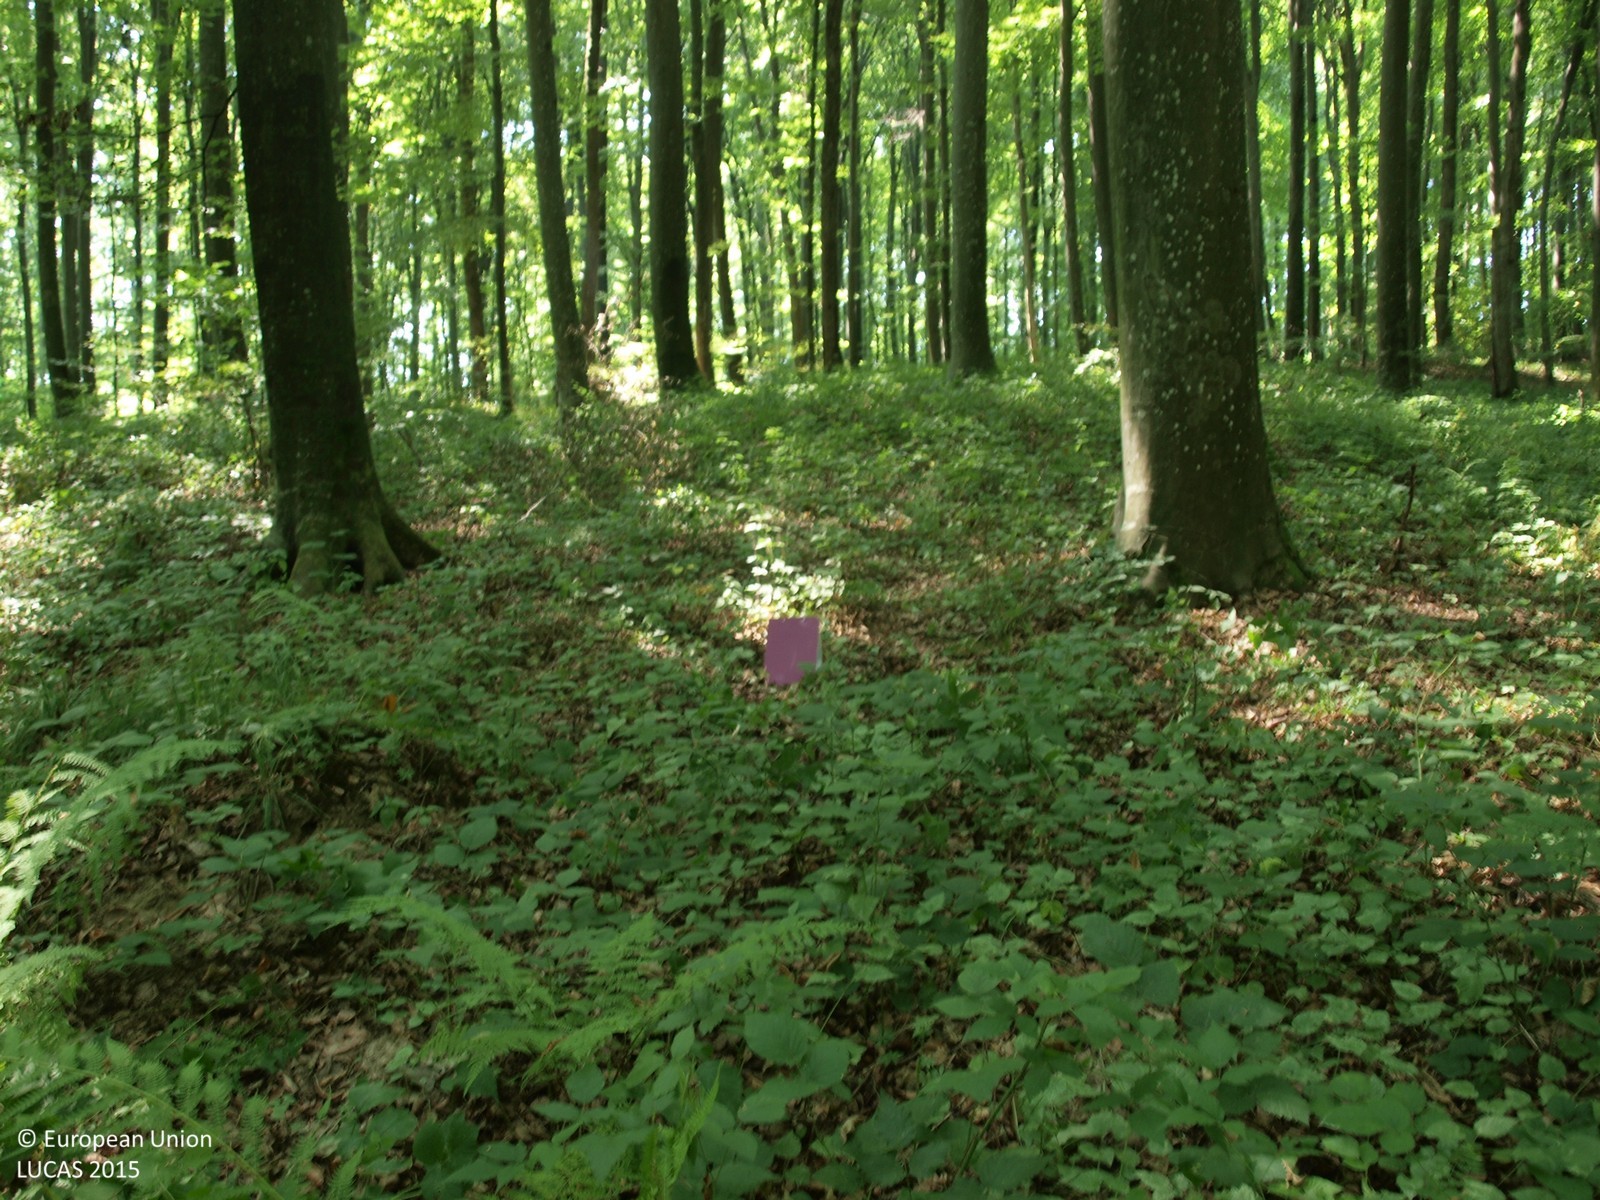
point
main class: Woodland
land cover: Broadleaved woodland
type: beech forest
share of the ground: > 75 %
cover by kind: broadleaved forest trees 100 %
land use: Forestry
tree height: > 5 m
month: August
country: HR
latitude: 45.9654
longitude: 16.6199
